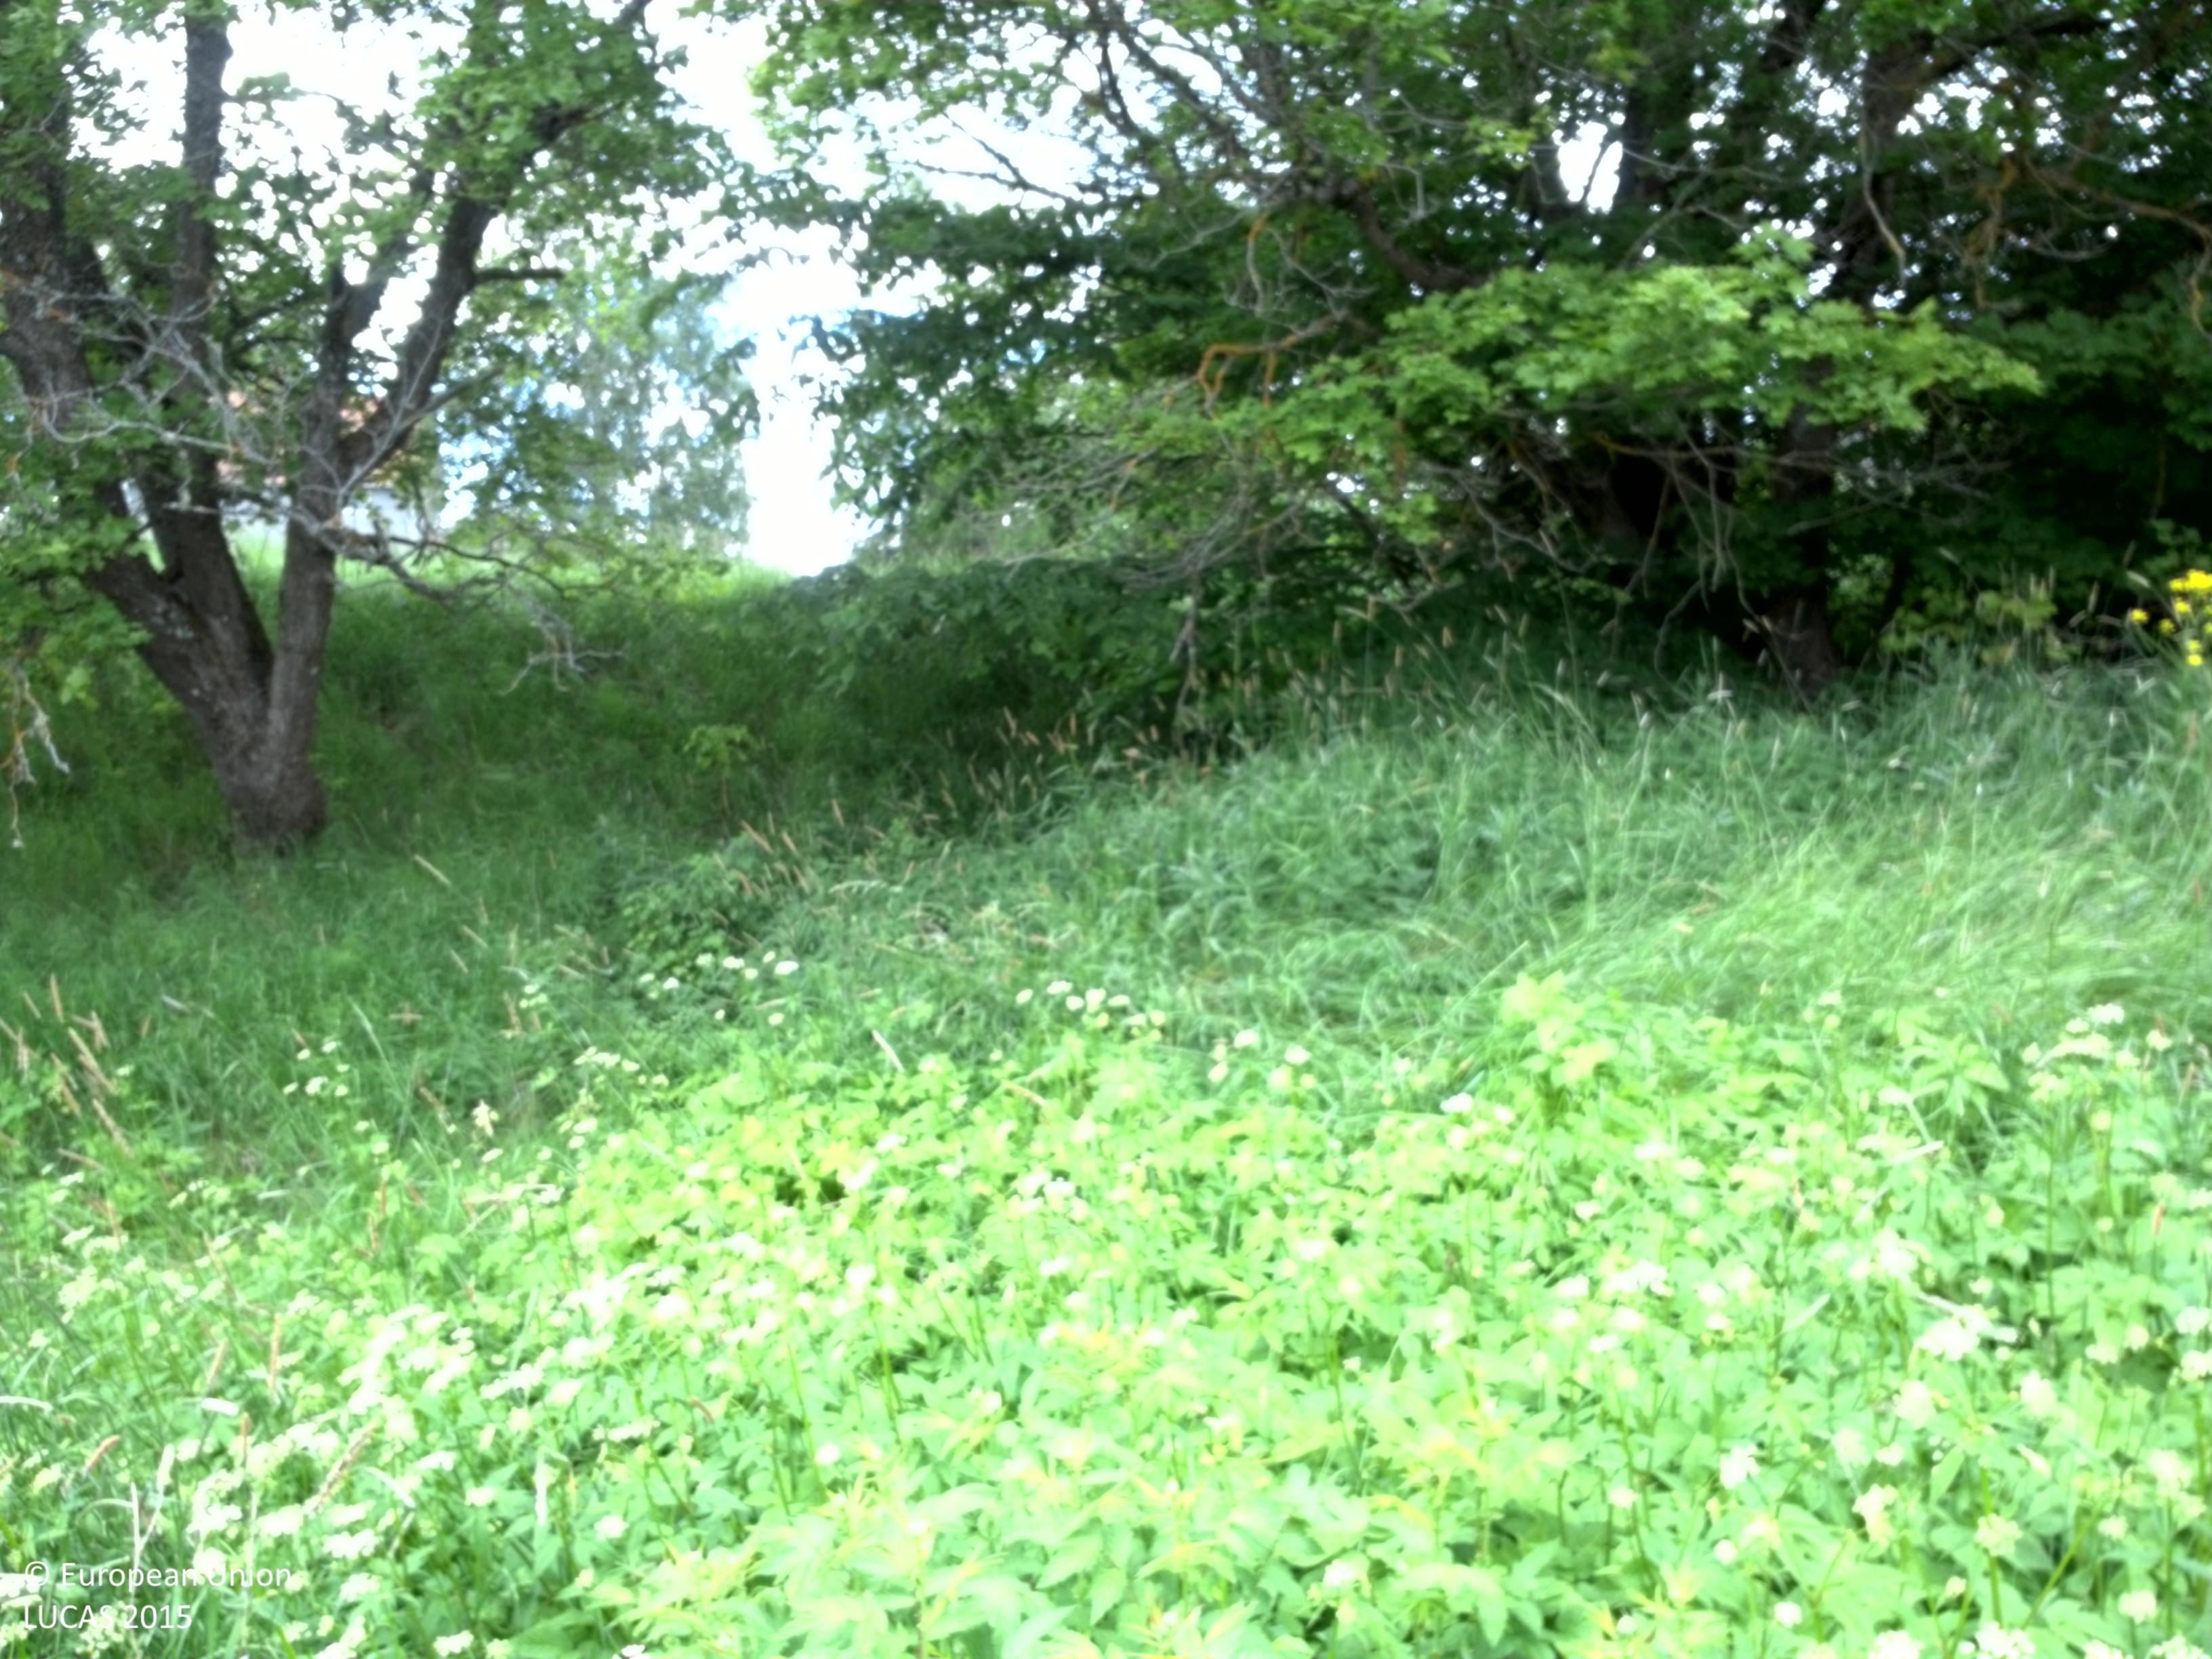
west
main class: Grassland
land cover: Grassland without tree/shrub cover
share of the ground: > 75 %
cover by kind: herbaceous plants 100 %
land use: Semi-natural and natural areas not in use
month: June
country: SE
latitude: 59.8679
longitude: 17.5842
